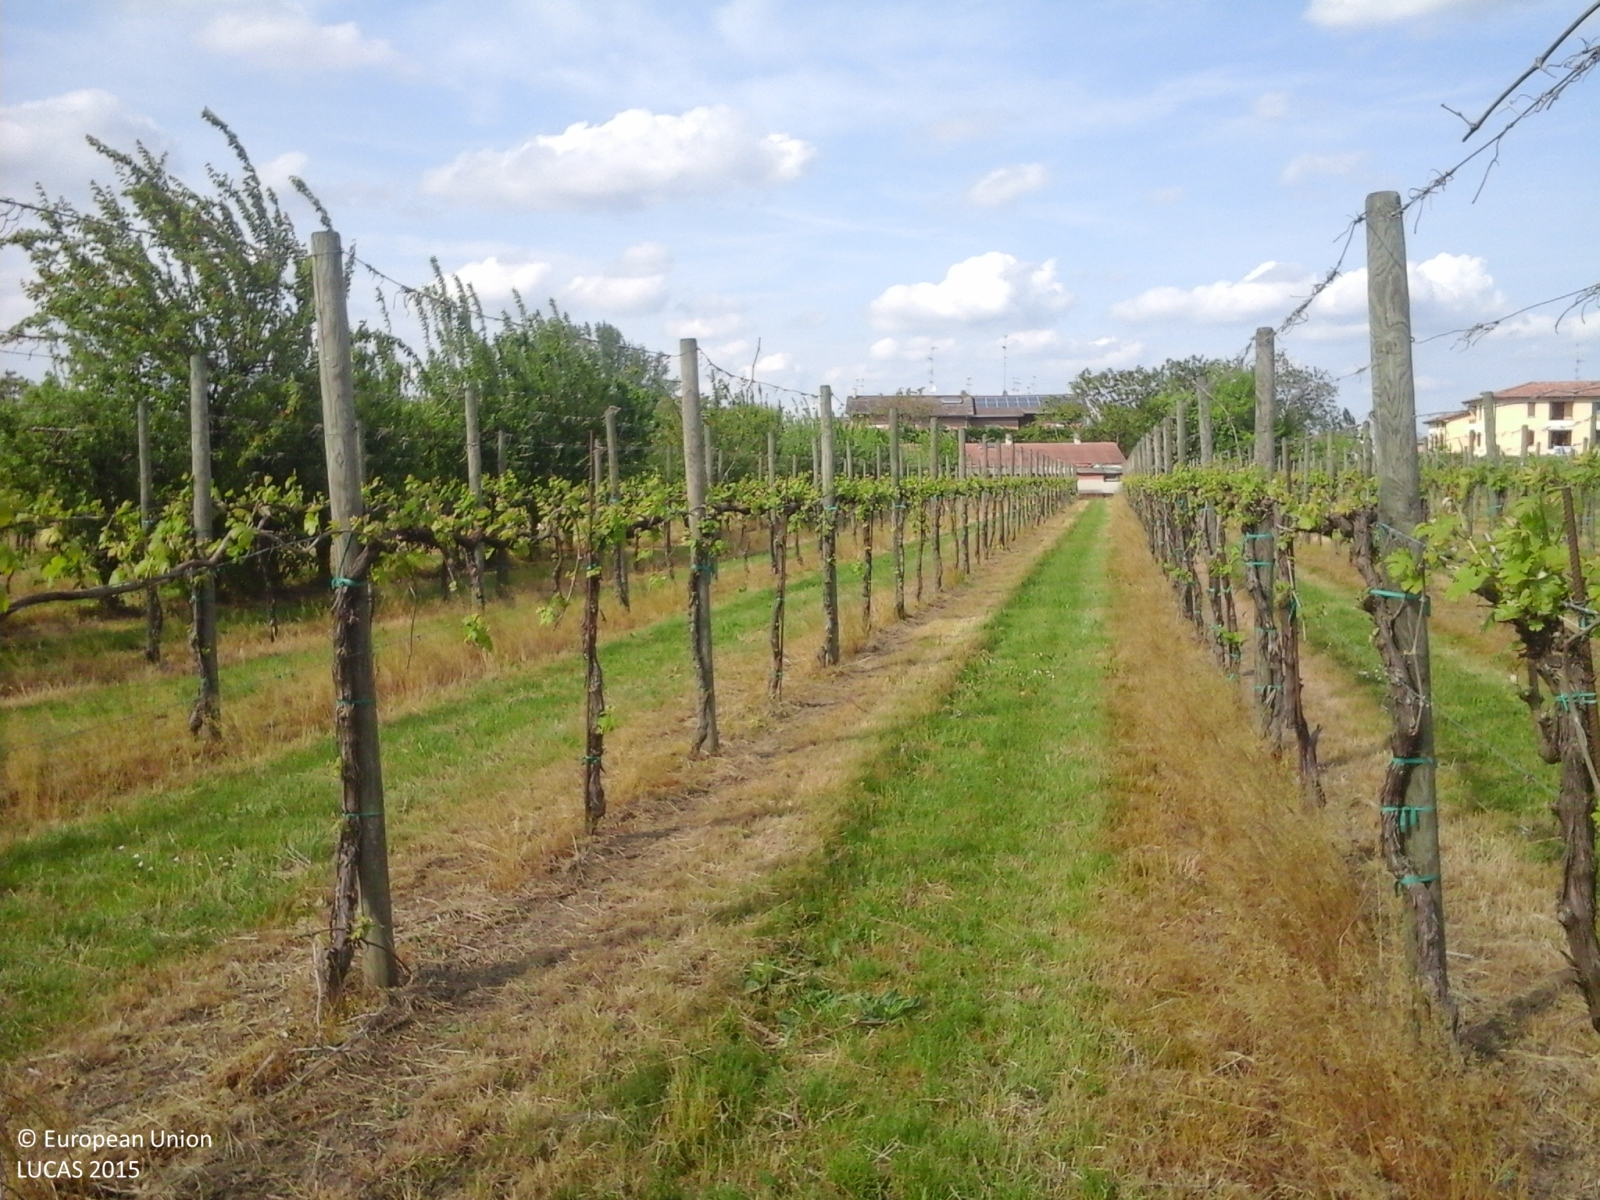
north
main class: Cropland
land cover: Vineyards
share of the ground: 10 - 25 %
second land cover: Grassland without tree/shrub cover
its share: > 75 %
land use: Agriculture (excluding fallow land and kitchen gardens)
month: April
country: IT
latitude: 44.8705
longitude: 10.7958
